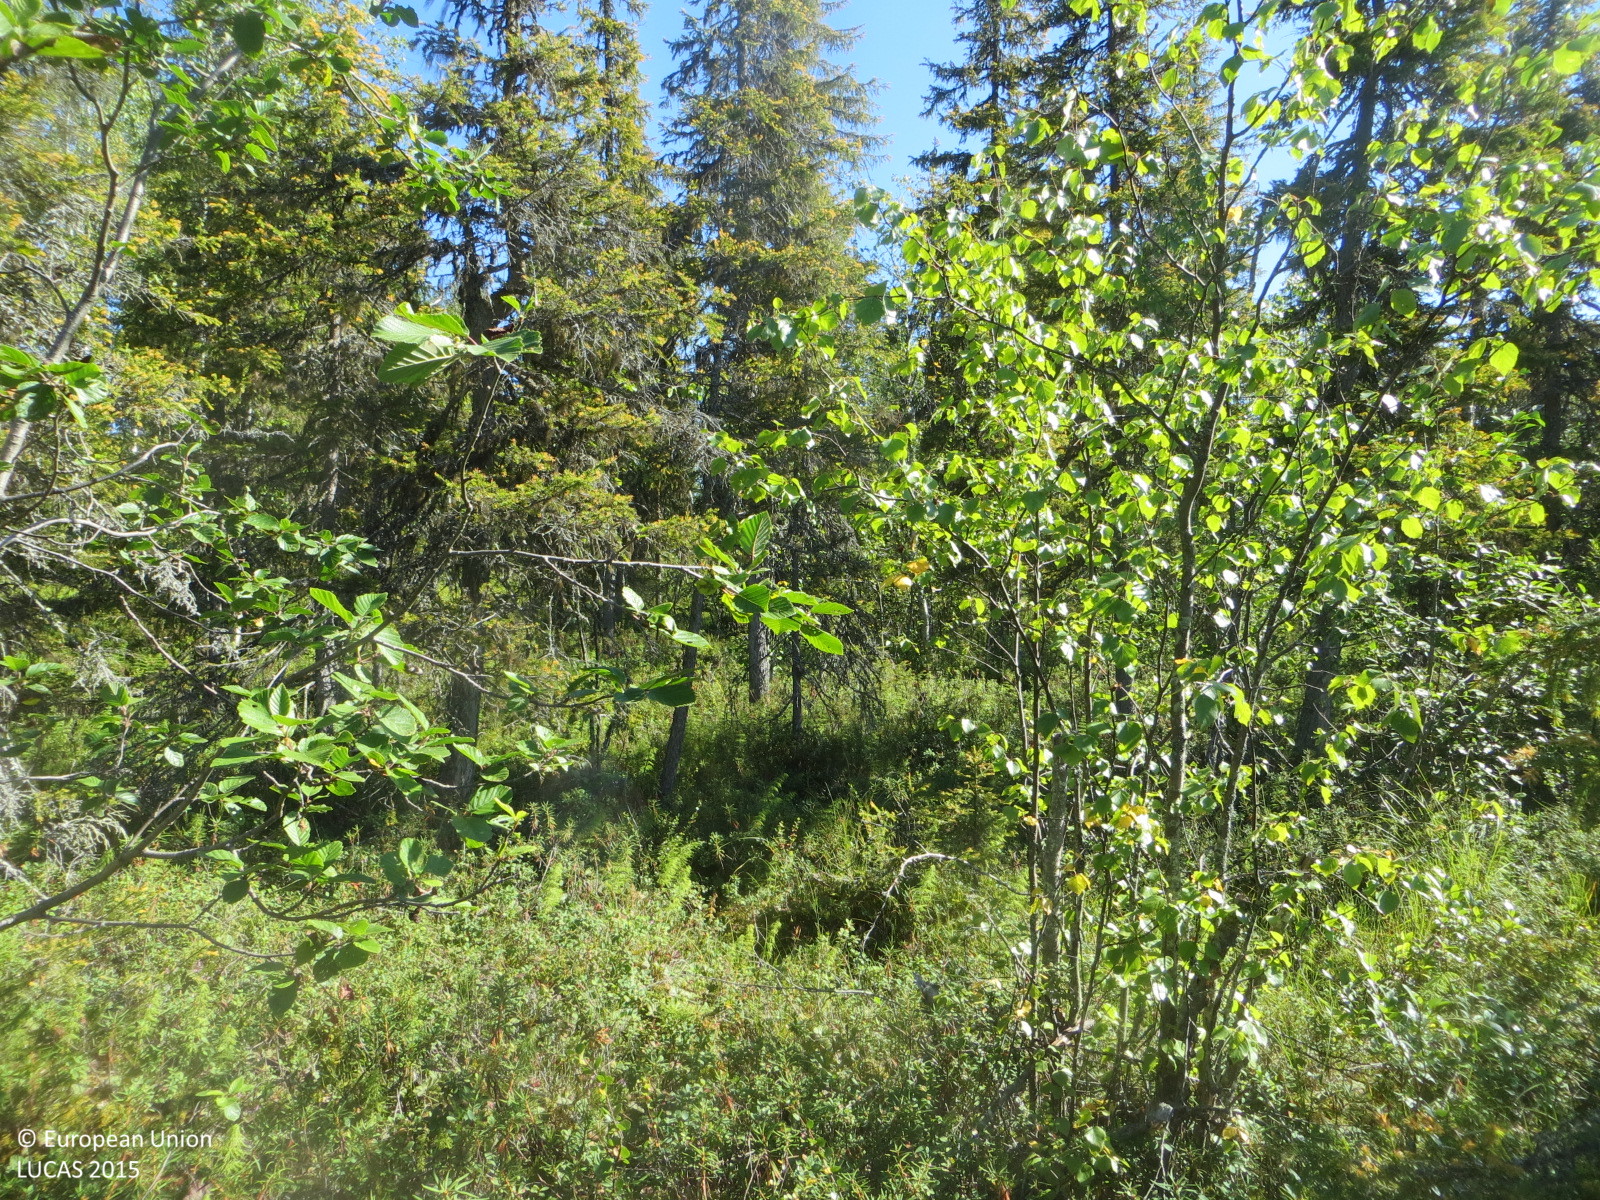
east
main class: Woodland
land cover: Spruce dominated mixed woodland
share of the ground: 50 - 75 %
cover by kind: shrubs 50 %, coniferous forest trees 25 %, broadleaved forest trees 25 %
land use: Forestry
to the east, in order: Spruce dominated mixed woodland; Pine dominated mixed woodland; Tracks; Shrubland with sparse tree cover; Pine dominated coniferous woodland
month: August
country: FI
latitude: 67.1733
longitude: 23.9087
